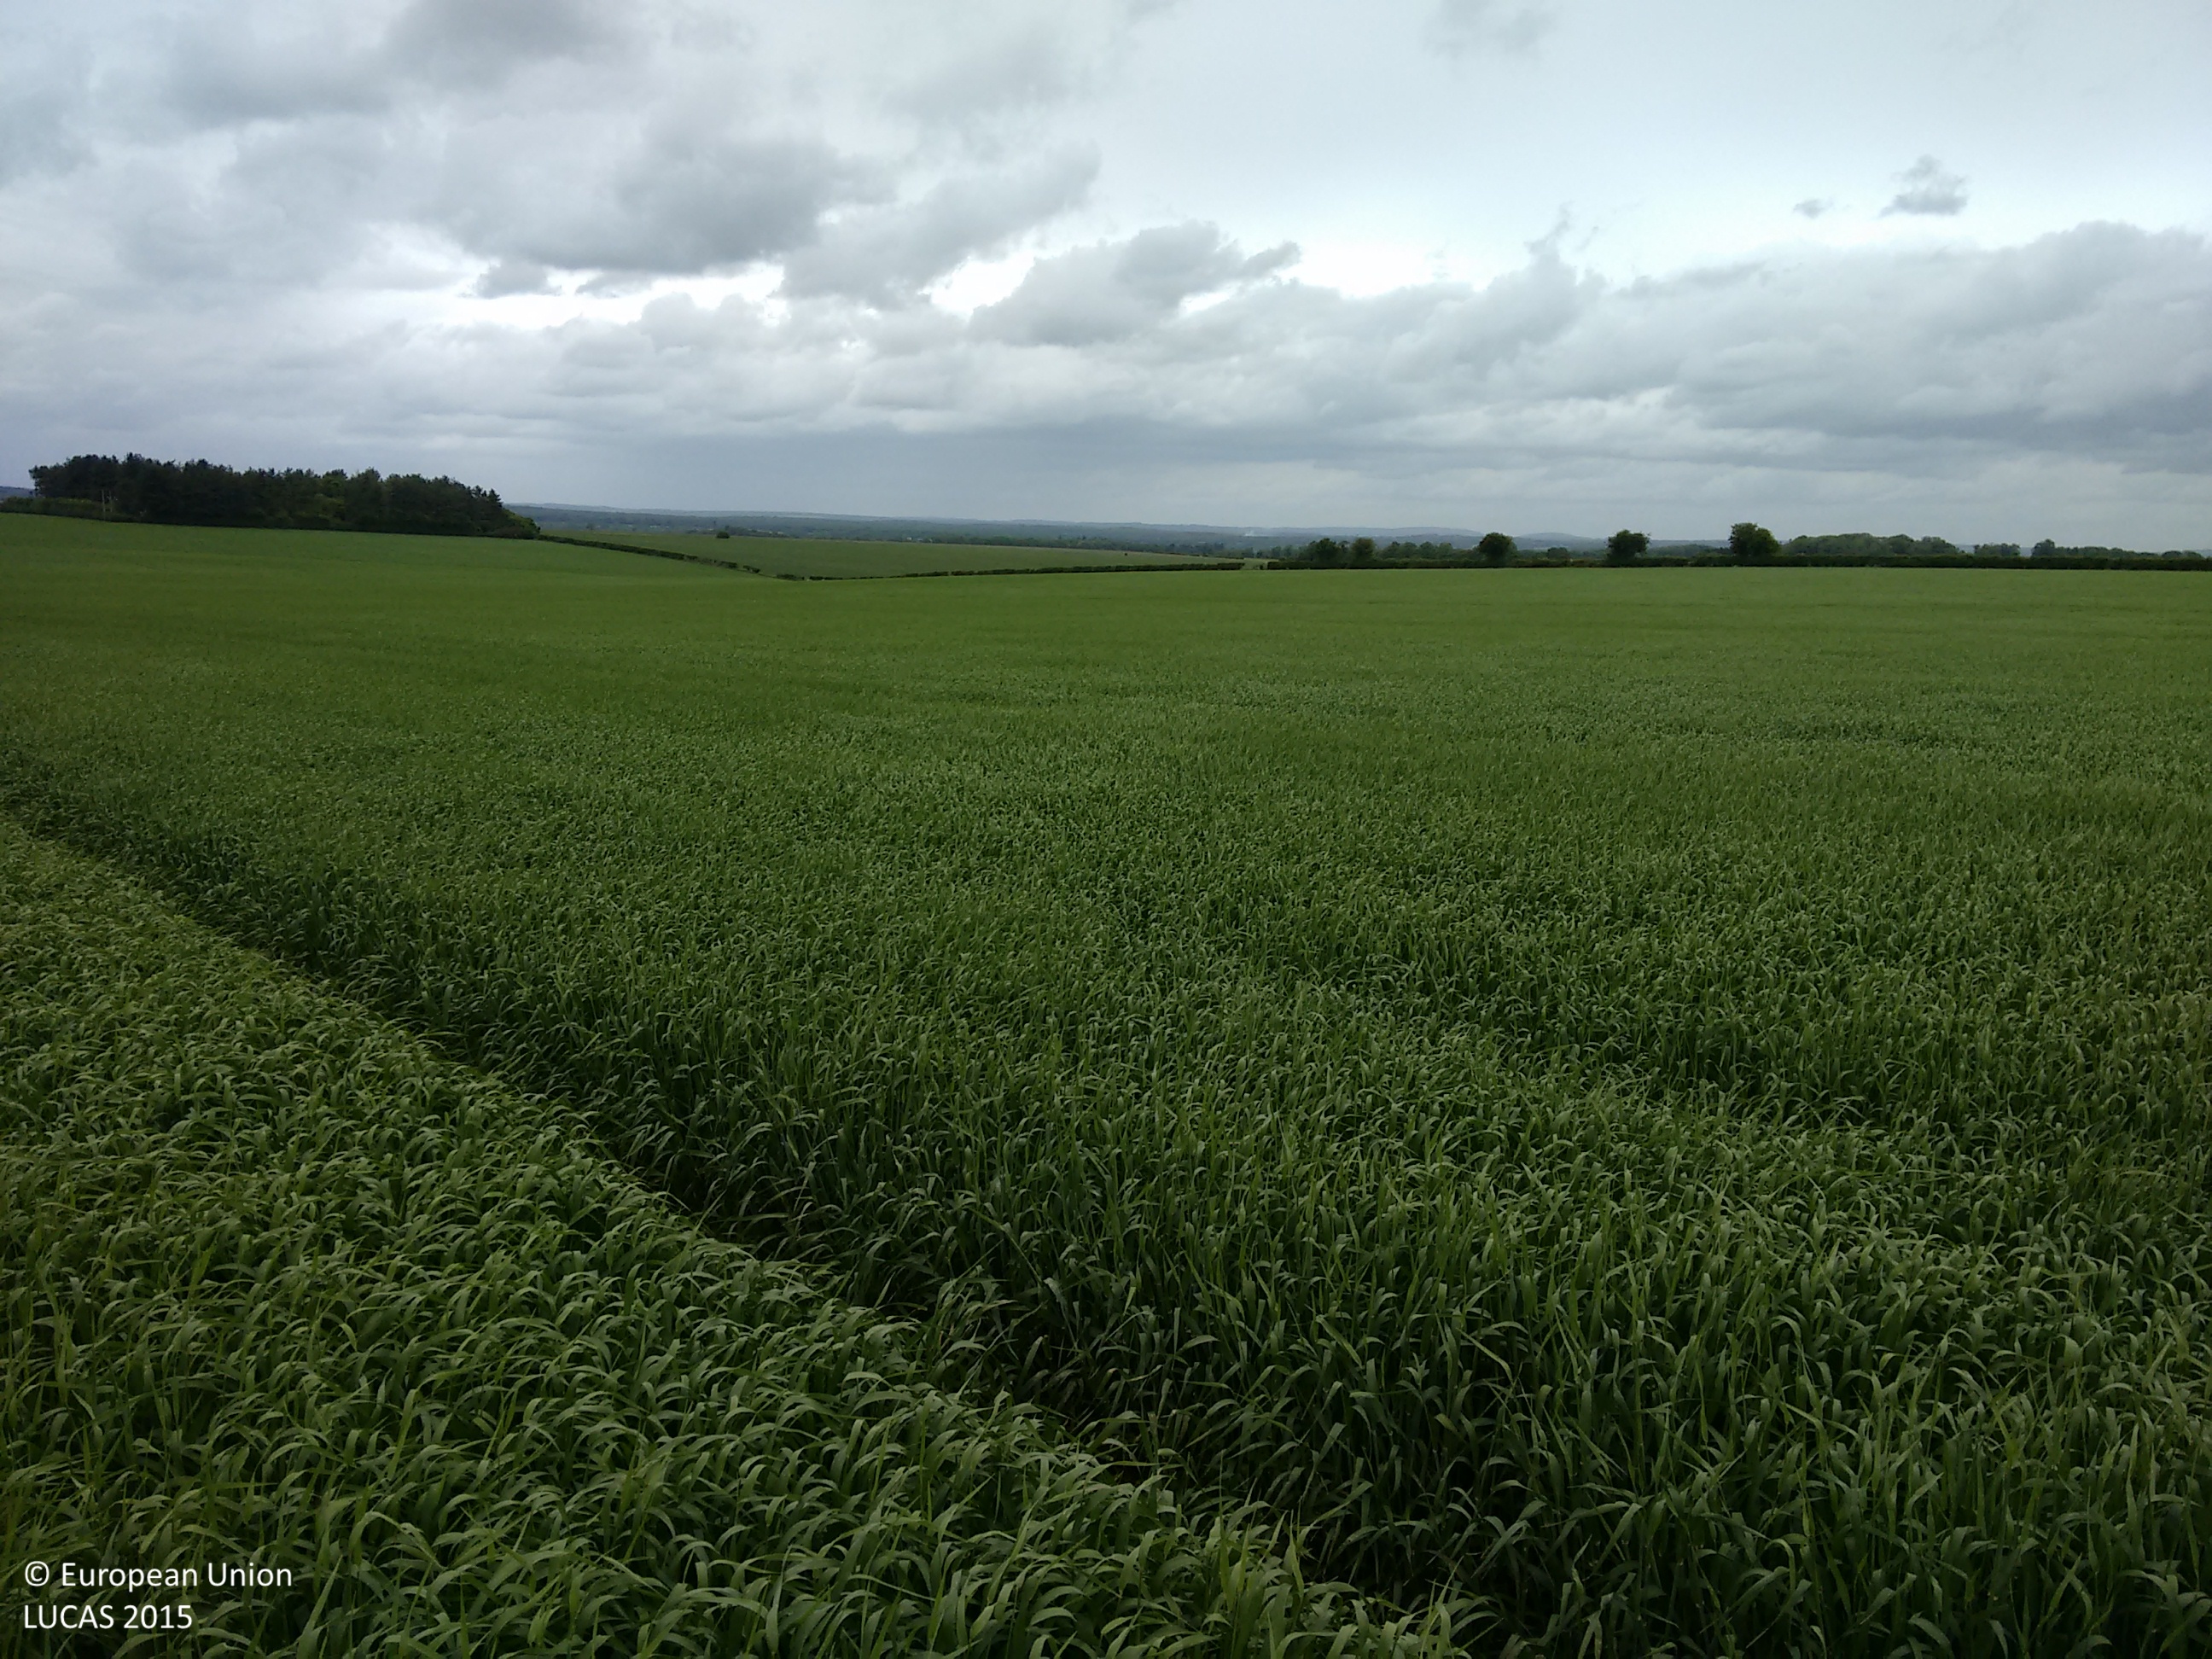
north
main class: Cropland
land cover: Barley
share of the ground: > 75 %
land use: Agriculture (excluding fallow land and kitchen gardens)
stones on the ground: > 50 %
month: June
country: GB
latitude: 51.1349
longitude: -1.4115
